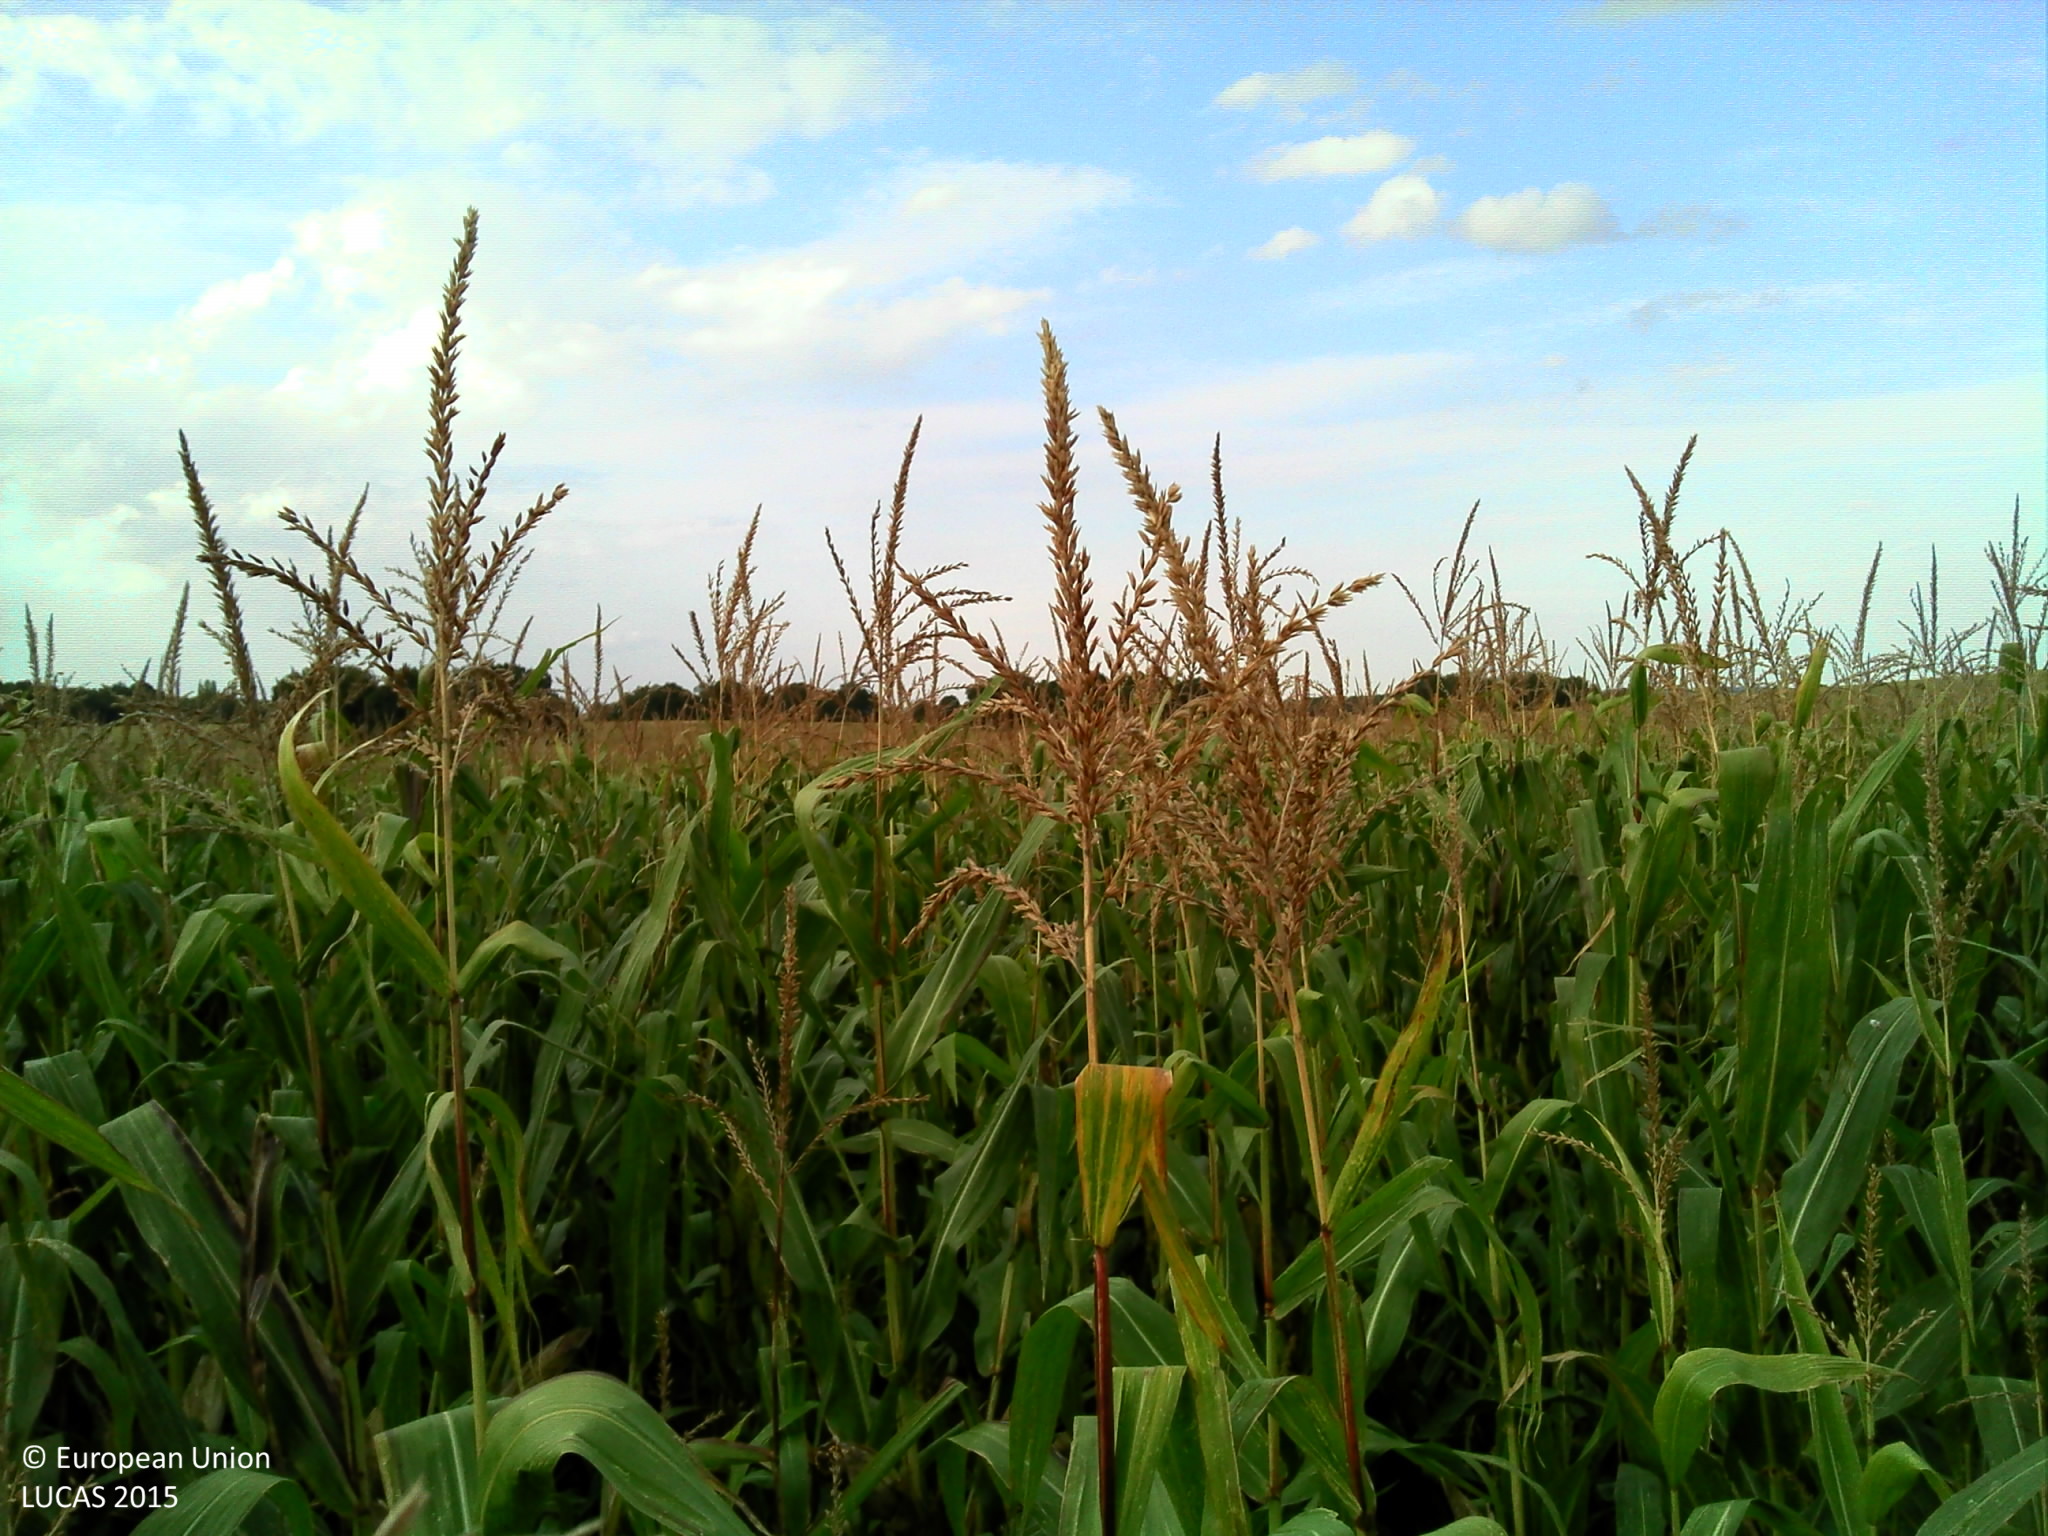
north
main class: Cropland
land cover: Maize
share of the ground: > 75 %
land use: Agriculture (excluding fallow land and kitchen gardens)
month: September
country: FR
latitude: 46.7251
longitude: 0.9175
